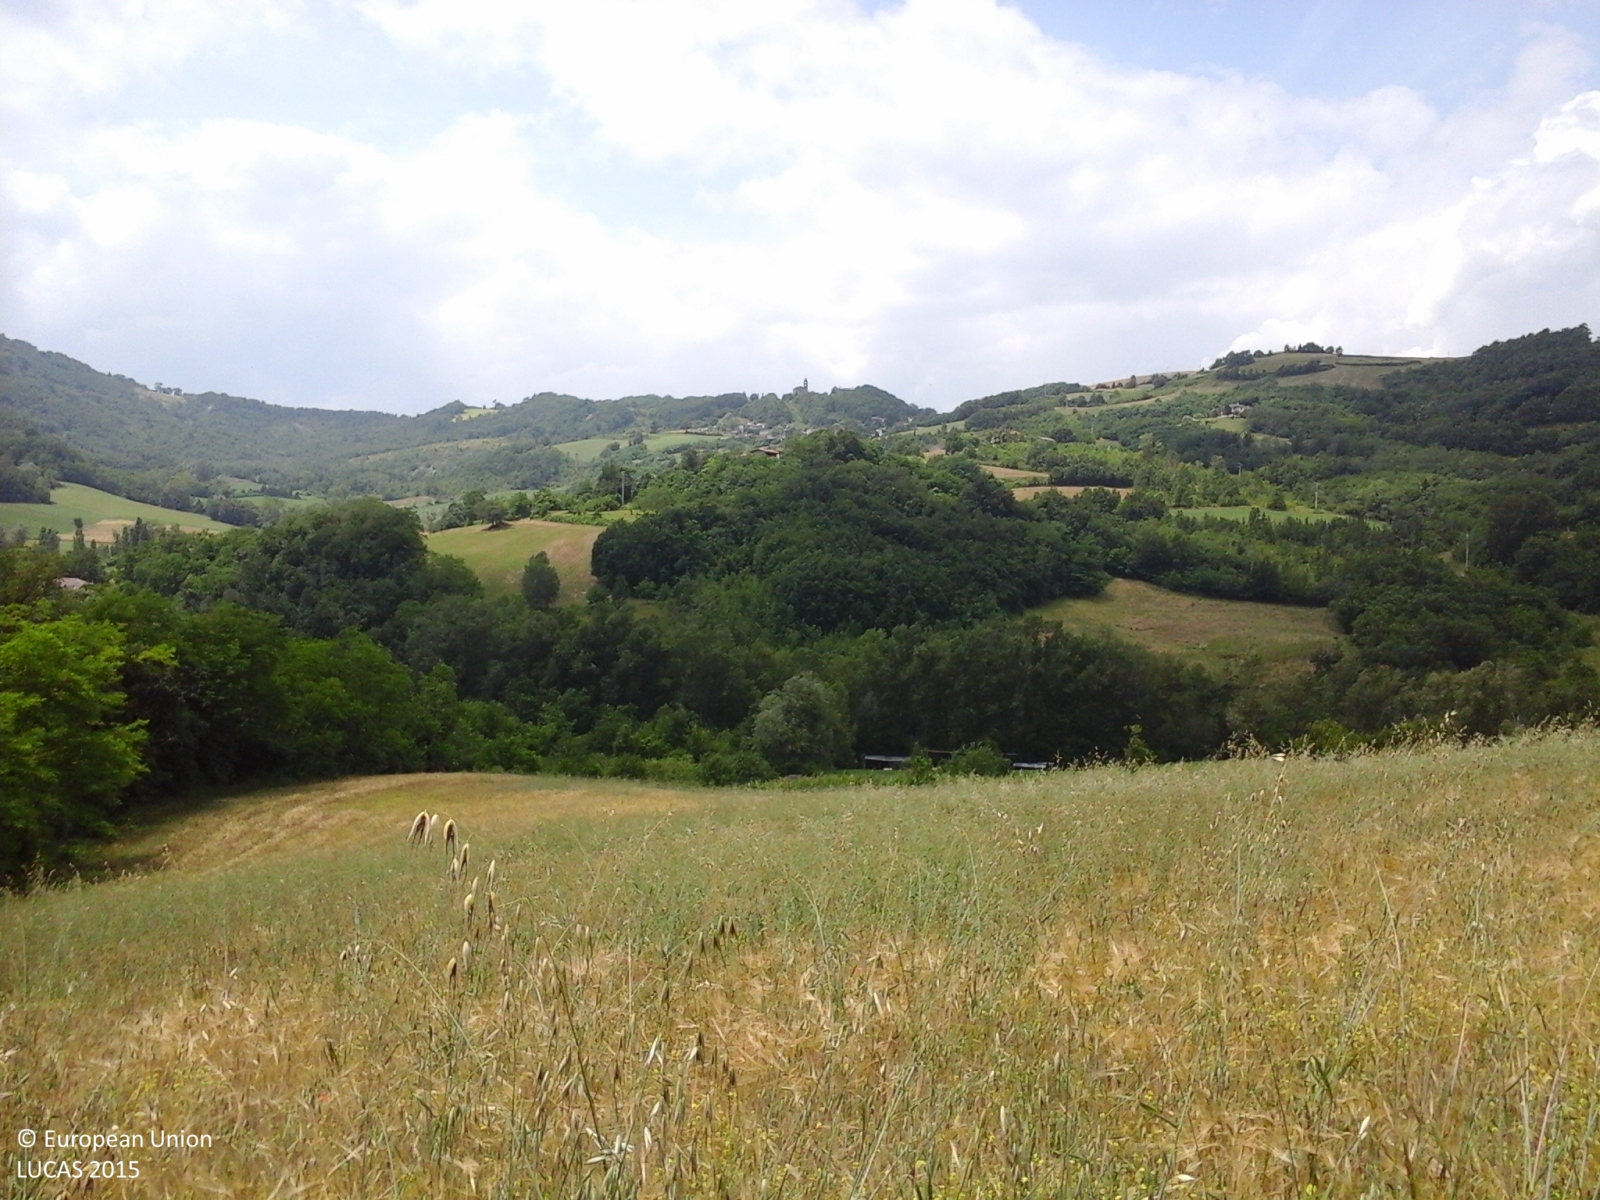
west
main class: Cropland
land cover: Barley
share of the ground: > 75 %
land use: Agriculture (excluding fallow land and kitchen gardens)
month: June
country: IT
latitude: 44.8189
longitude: 9.6845
